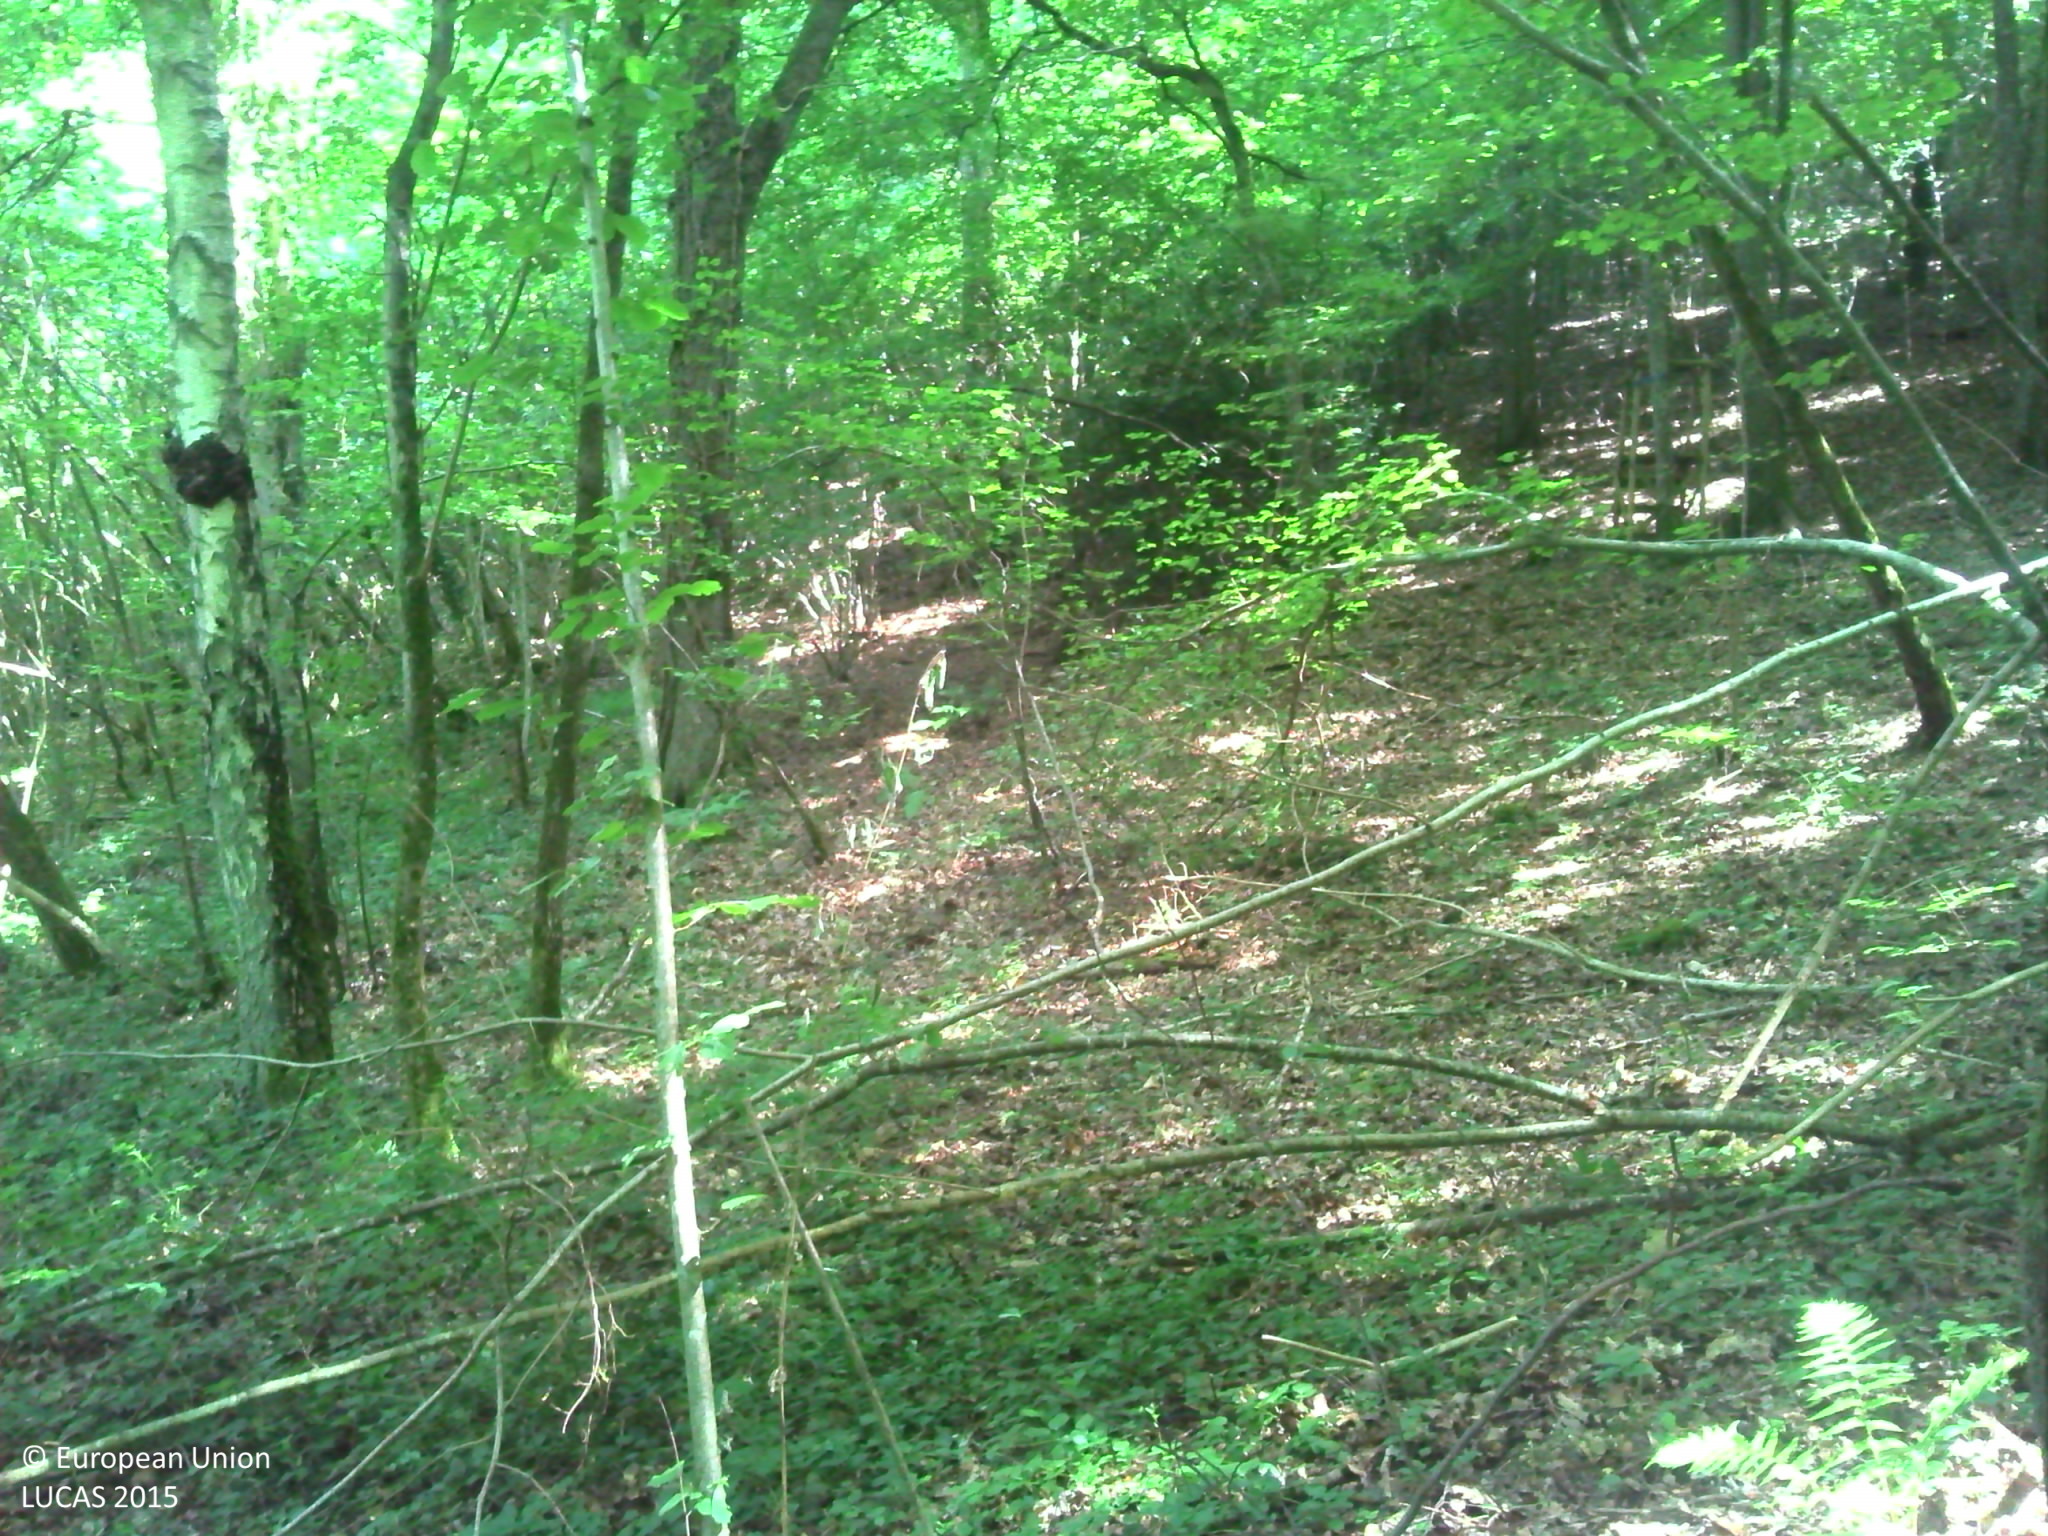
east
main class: Woodland
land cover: Broadleaved woodland
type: mesophytic deciduous forest
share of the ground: > 75 %
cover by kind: broadleaved forest trees 80 %, herbaceous plants 10 %, lichens and mosses 5 %, consolidated bare surface 5 %
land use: Forestry
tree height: > 5 m
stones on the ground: < 10 %
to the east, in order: Broadleaved woodland
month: June
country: FR
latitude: 49.0930
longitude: 1.0913
